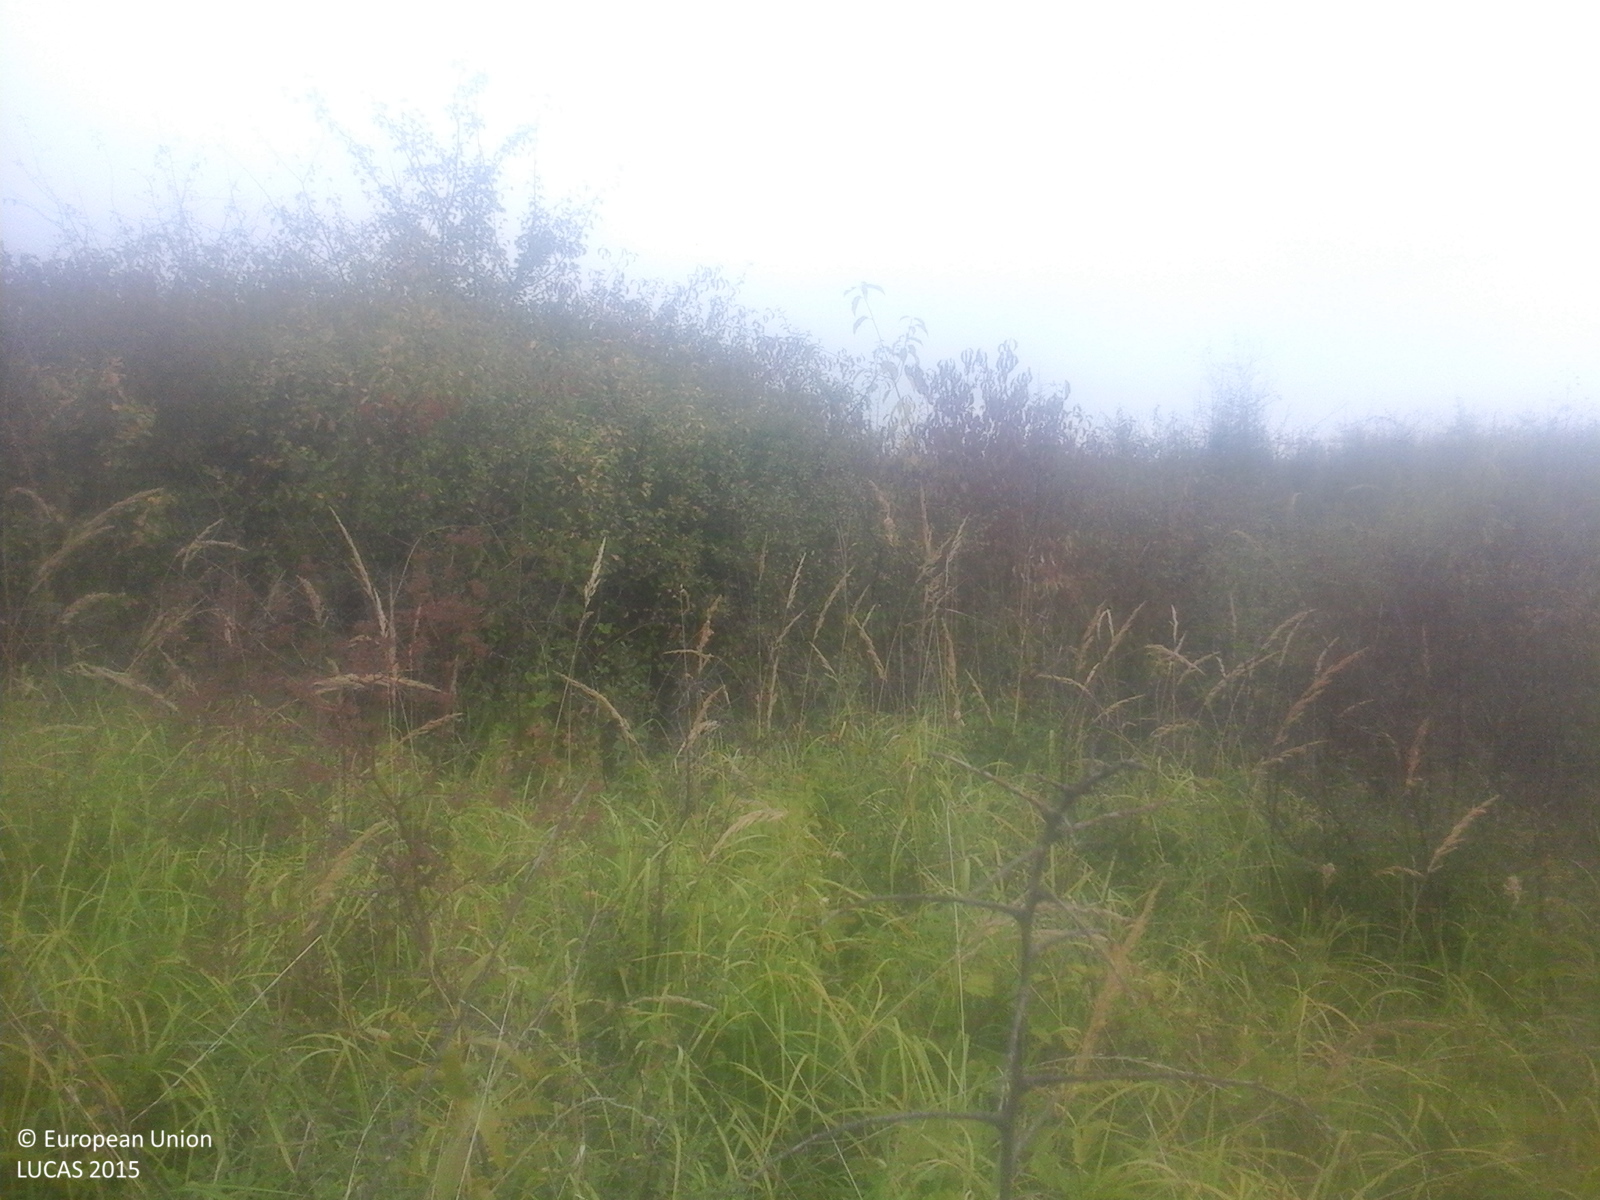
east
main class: Shrubland
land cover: Shrubland without tree cover
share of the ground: > 75 %
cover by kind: shrubs 60 %, herbaceous plants 40 %
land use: Fallow land
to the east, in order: Shrubland without tree cover; Shrubland with sparse tree cover; Other bare soil; Common wheat
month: September
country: RO
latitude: 45.4815
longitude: 21.9225
